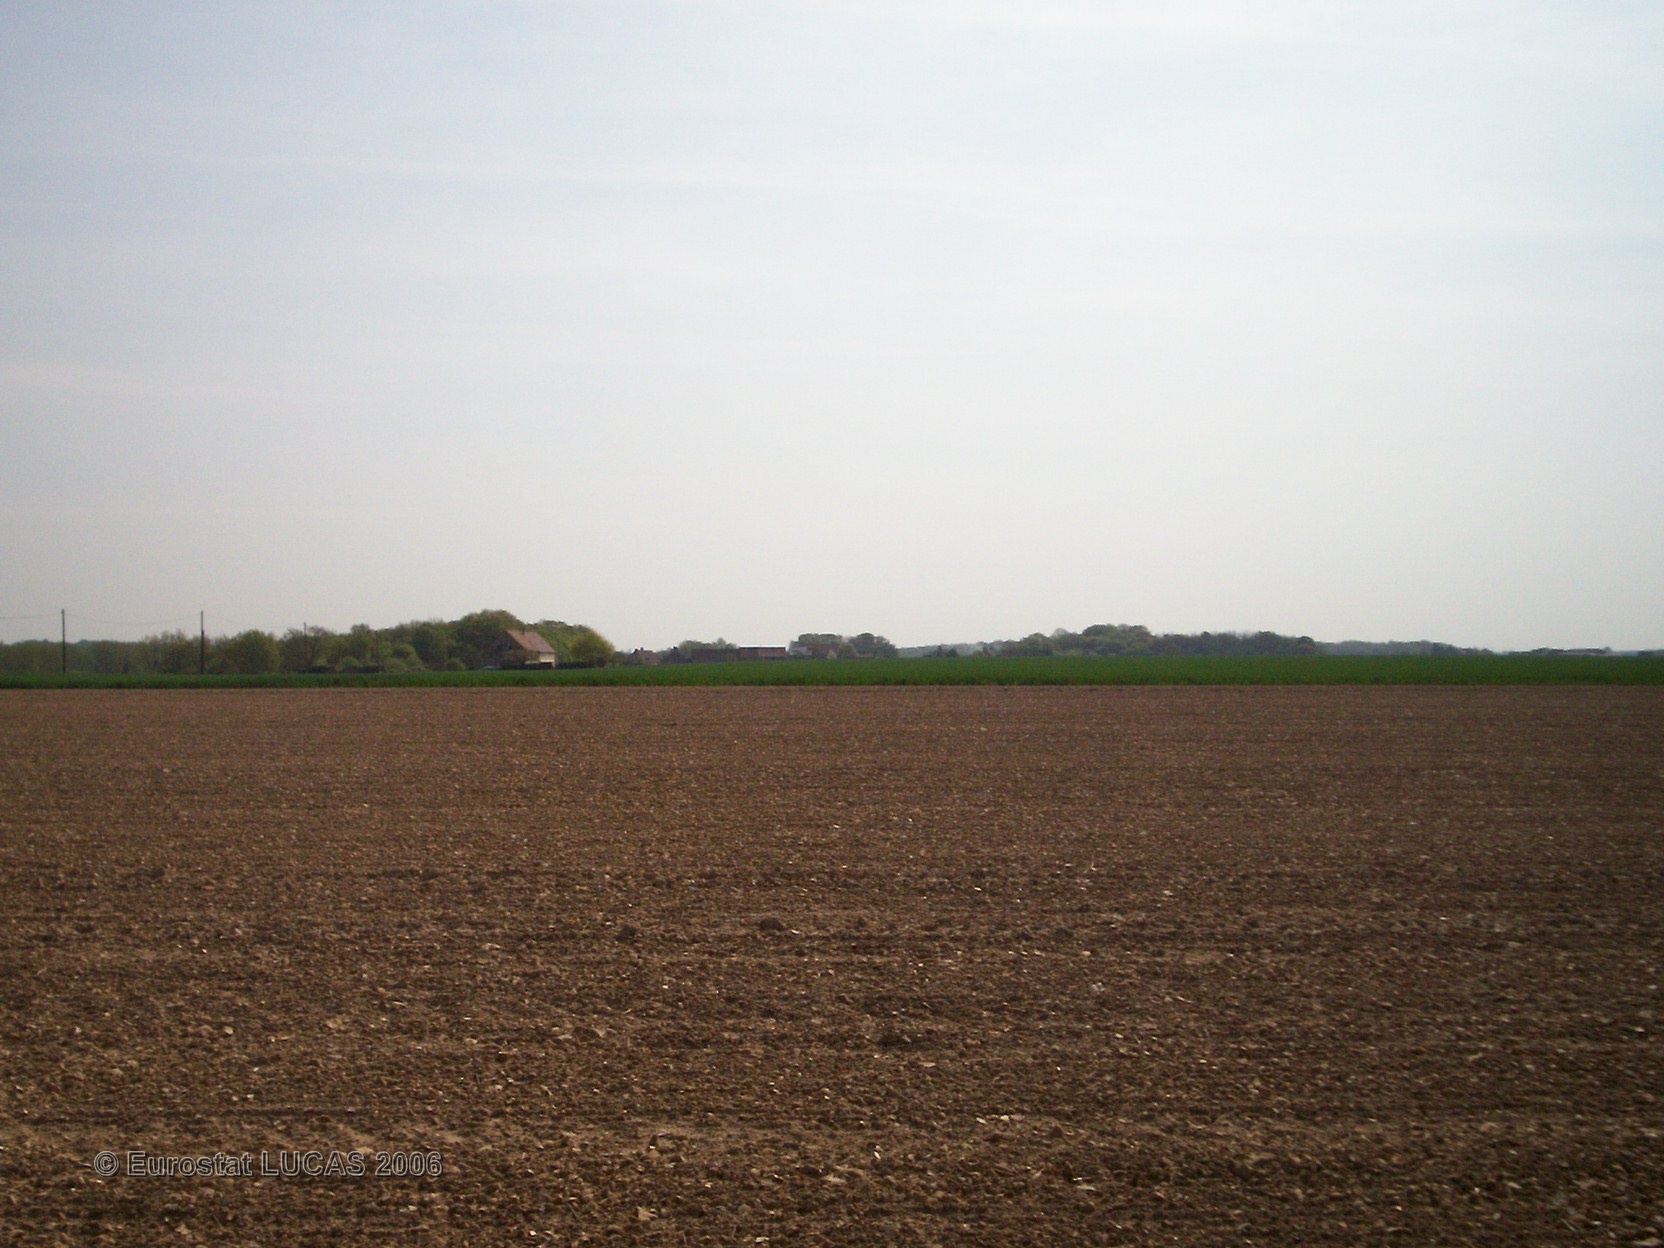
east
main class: Cropland
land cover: Sunflower
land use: Agriculture (excluding fallow land and kitchen gardens)
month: May
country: FR
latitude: 48.0502
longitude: 2.9225
